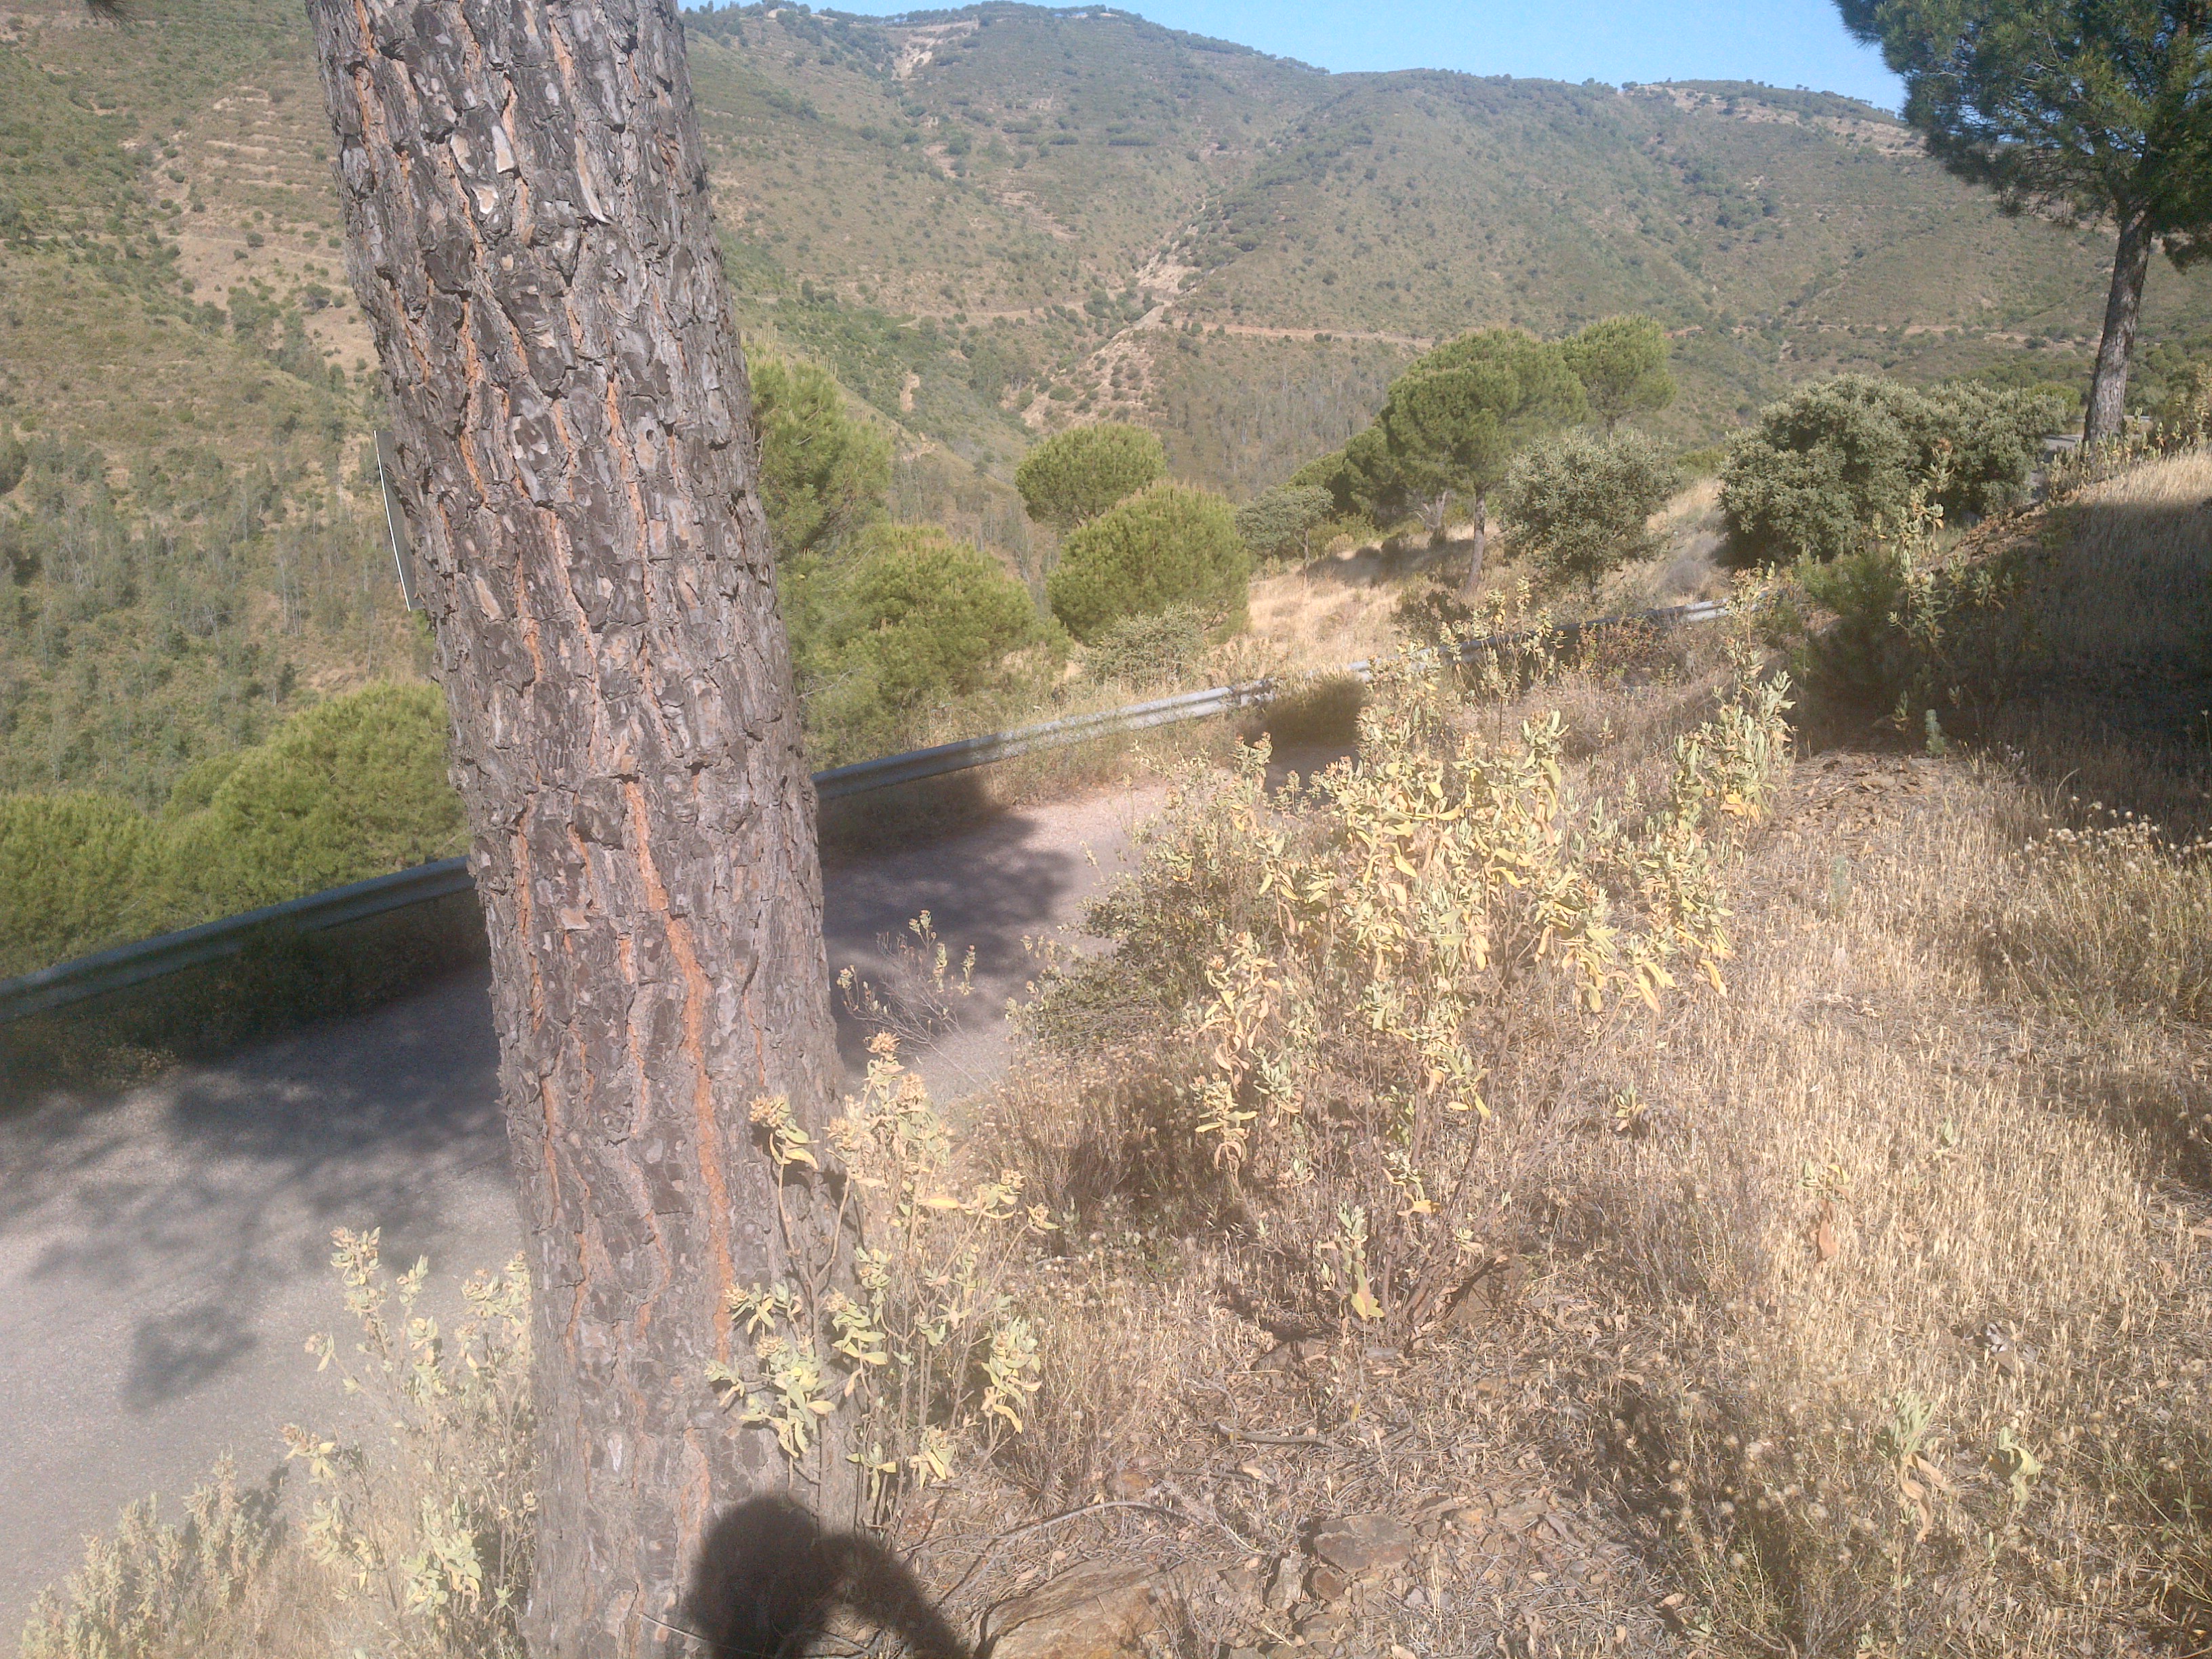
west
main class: Woodland
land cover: Pine dominated coniferous woodland
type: coniferous forest of the mediterranean region
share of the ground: 10 - 25 %
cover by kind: herbaceous plants 60 %, coniferous forest trees 20 %, shrubs 15 %, broadleaved forest trees 5 %
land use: Forestry
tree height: > 5 m
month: May
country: ES
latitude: 38.0361
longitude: -4.6790
